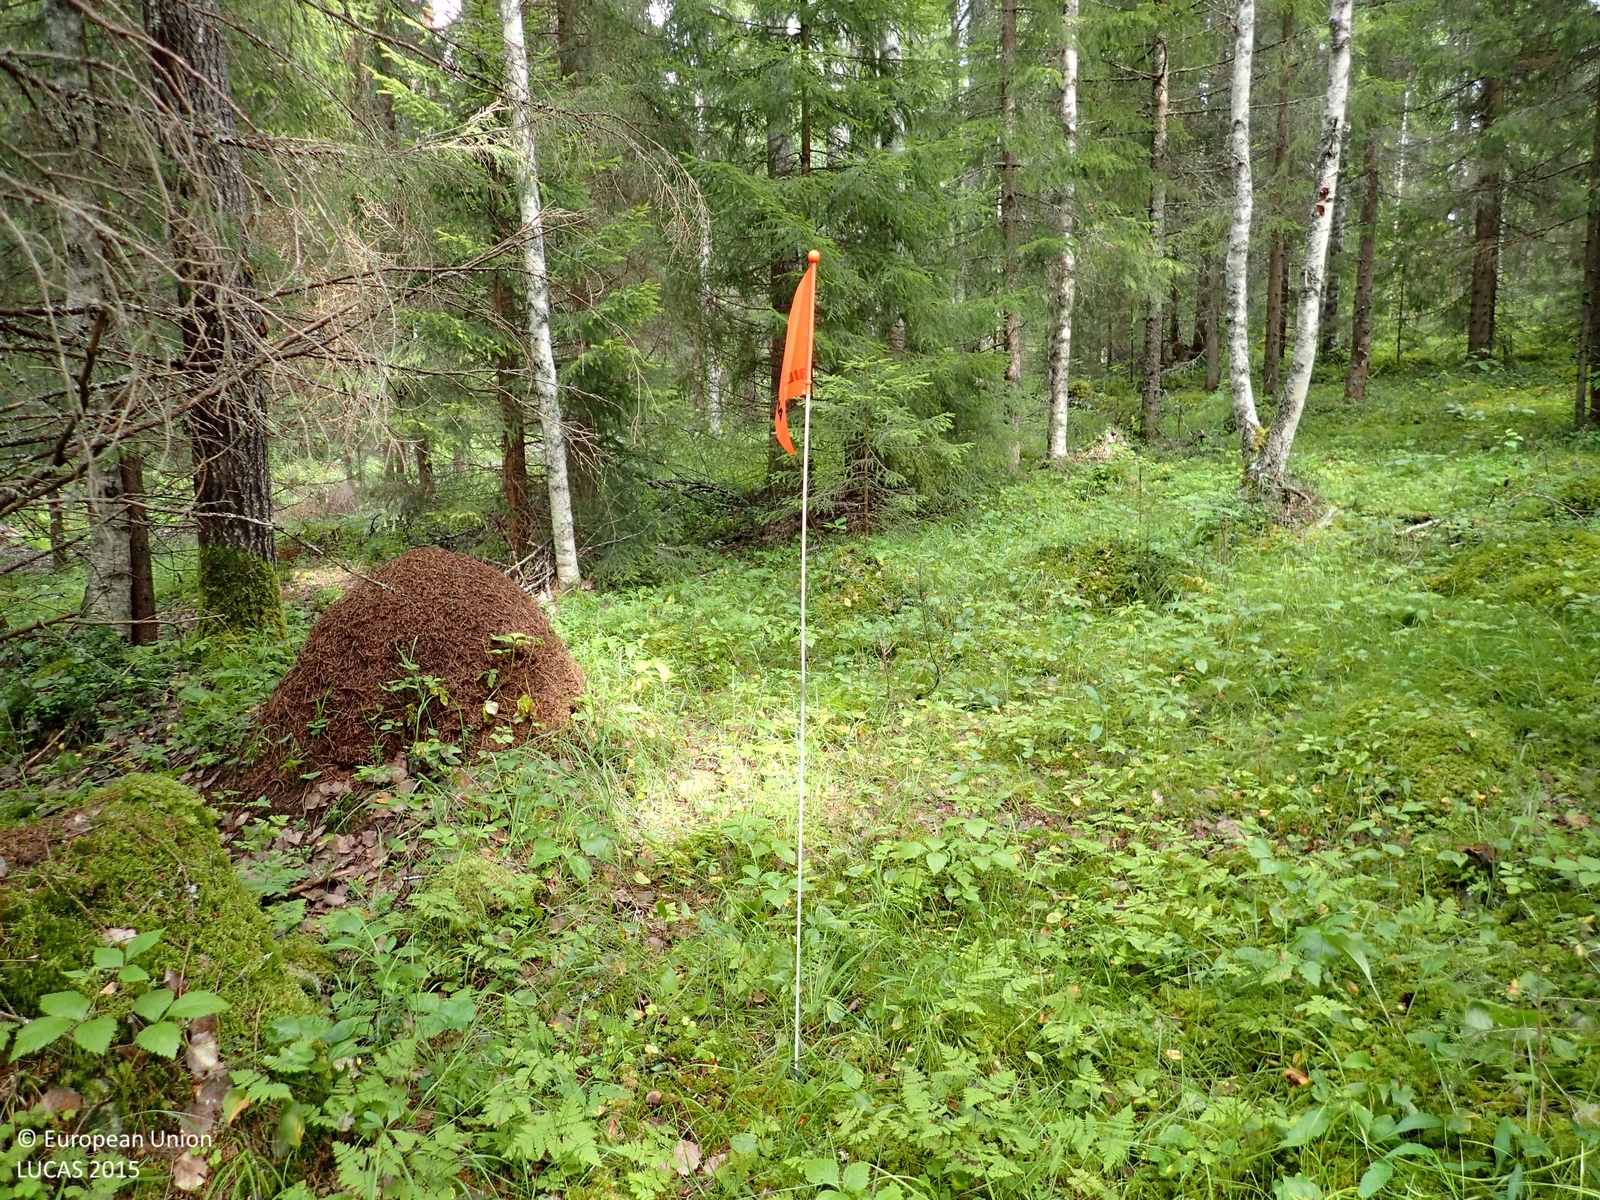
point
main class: Woodland
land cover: Spruce dominated mixed woodland
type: boreal forest
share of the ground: > 75 %
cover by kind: coniferous forest trees 60 %, broadleaved forest trees 20 %, herbaceous plants 10 %, shrubs 5 %, lichens and mosses 5 %
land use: Forestry
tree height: > 5 m
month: August
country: FI
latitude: 62.8314
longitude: 21.9221
